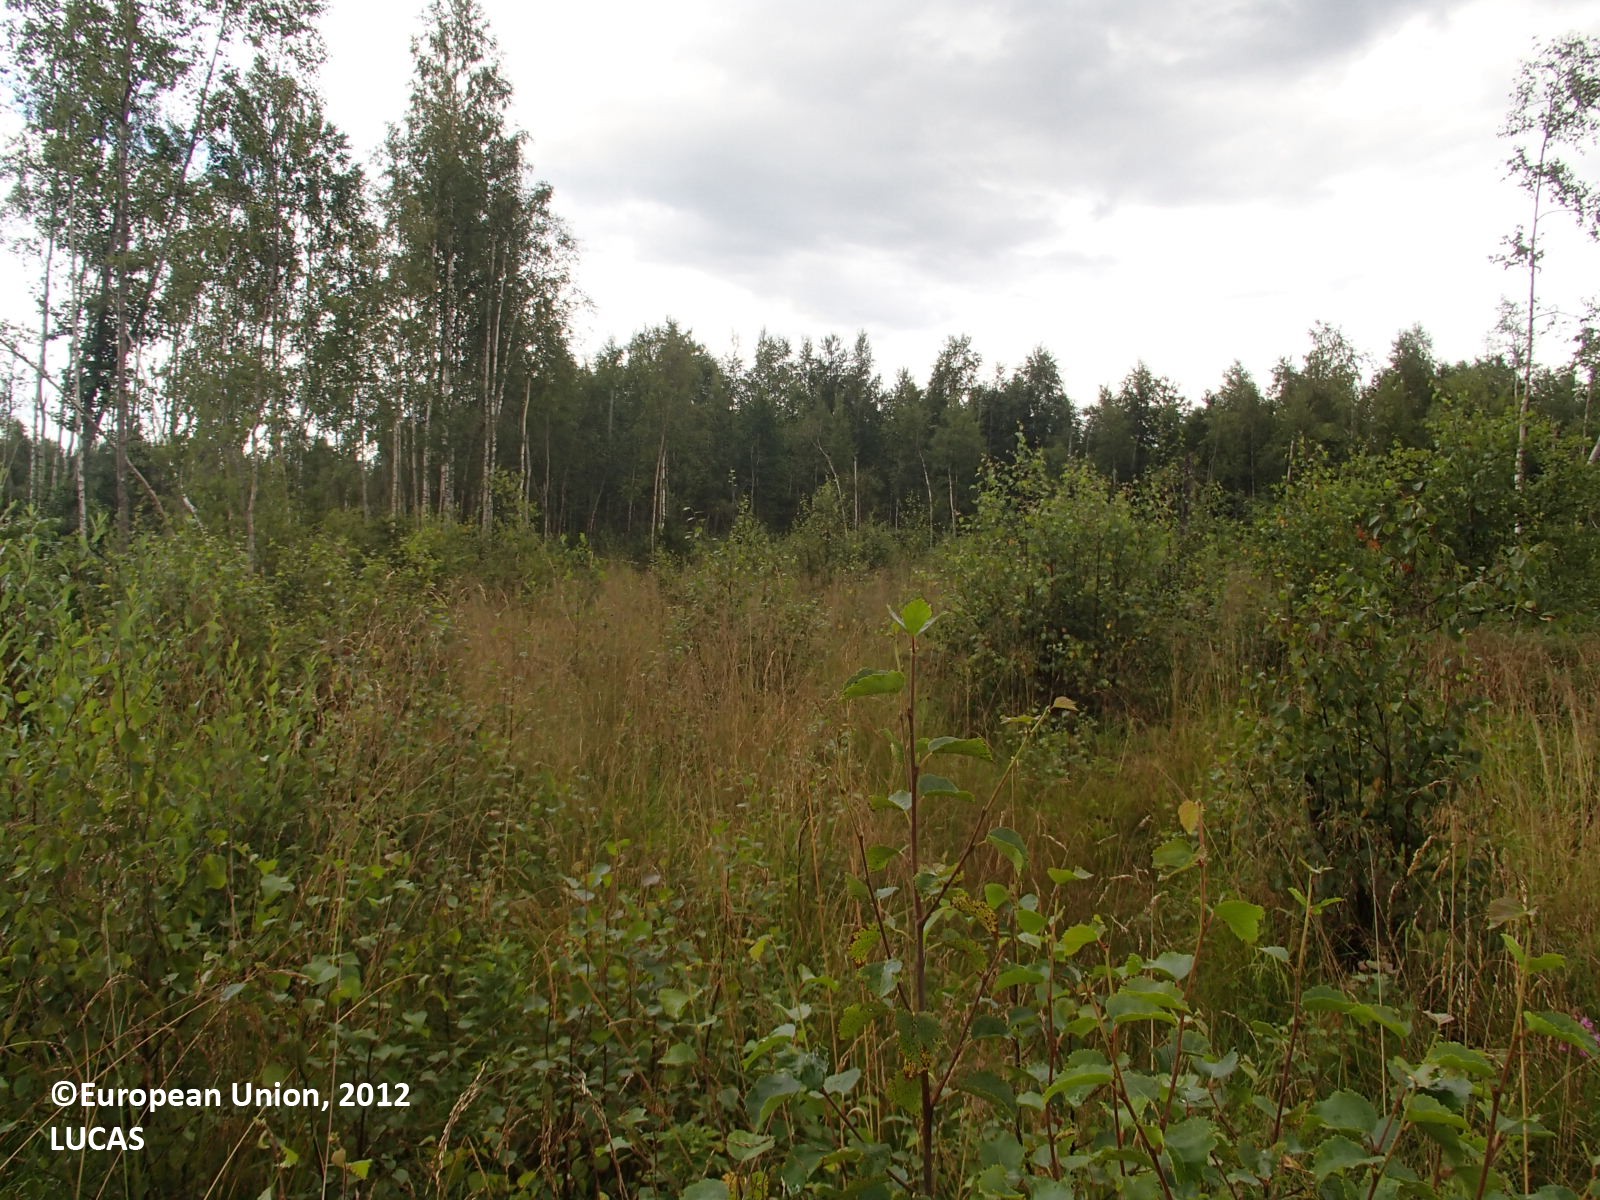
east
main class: Woodland
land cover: Spruce dominated mixed woodland
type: boreal forest
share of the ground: > 75 %
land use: Forestry
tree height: < 5 m
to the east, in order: Spruce dominated mixed woodland; Pine dominated mixed woodland; Other mixed woodland; Broadleaved woodland; Pine dominated mixed woodland; Broadleaved woodland; Pine dominated mixed woodland; Other mixed woodland; Broadleaved woodland
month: August
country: FI
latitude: 64.1144
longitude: 26.1859
